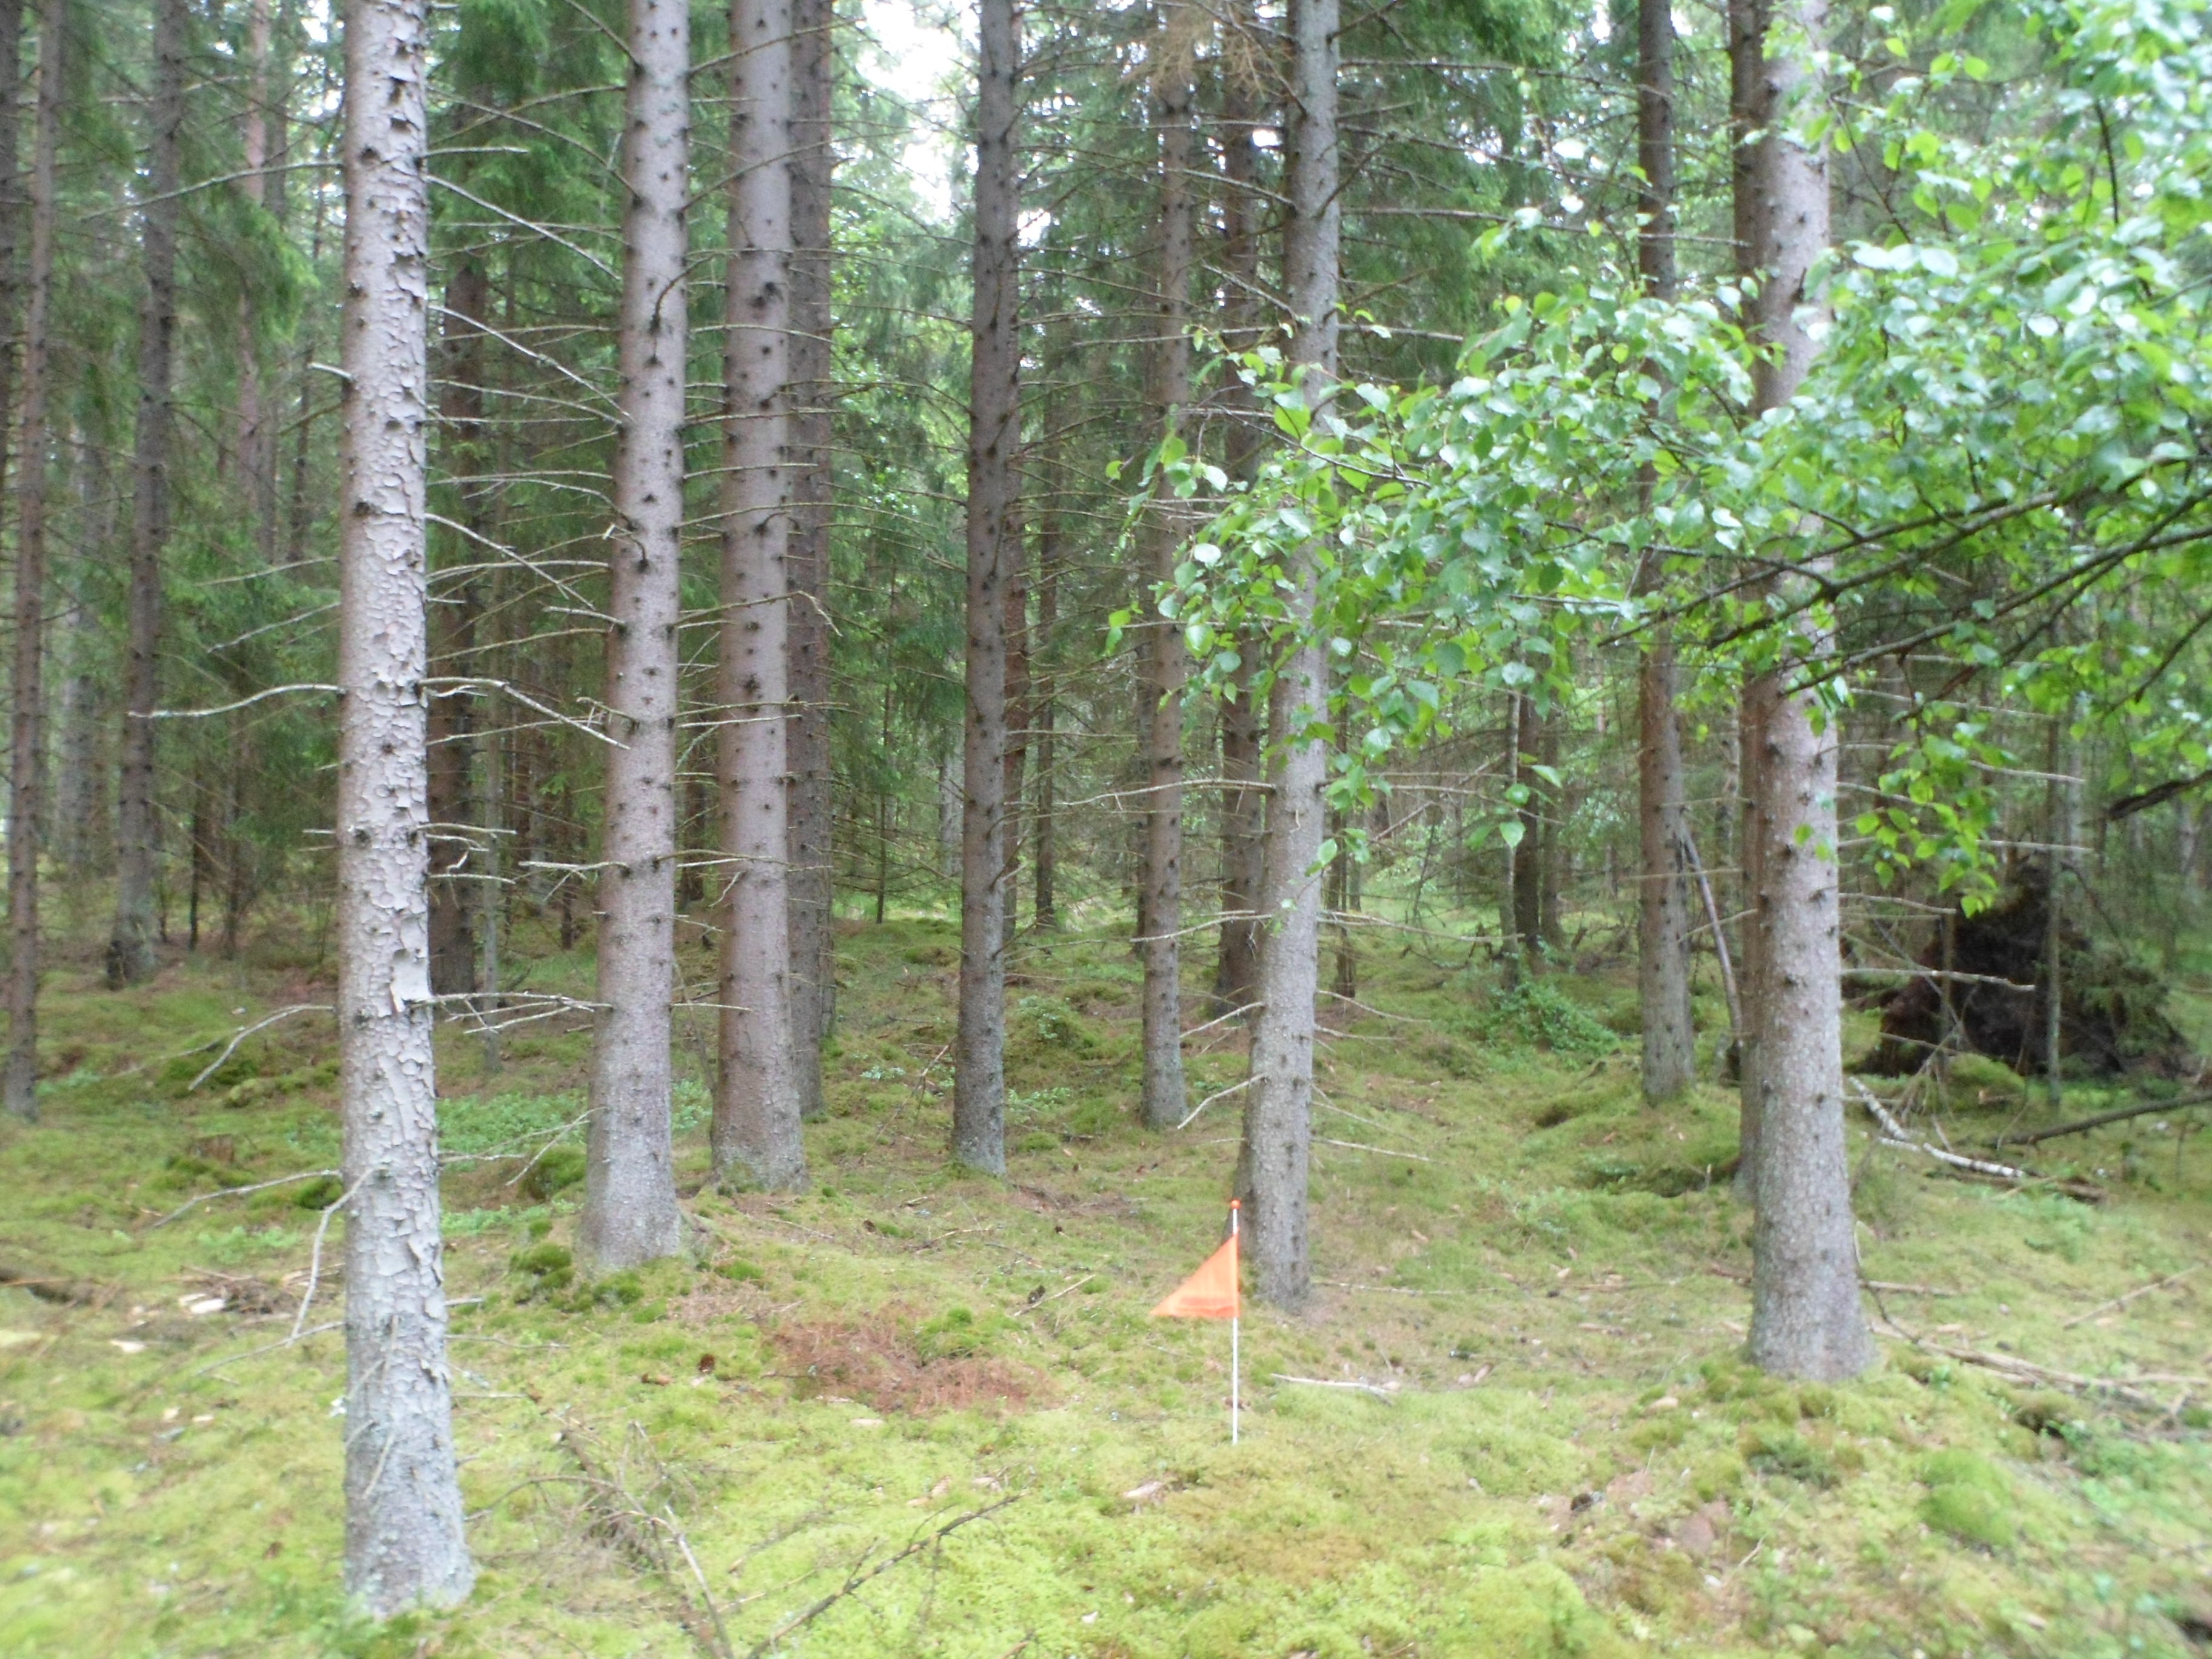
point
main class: Woodland
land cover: Spruce dominated coniferous woodland
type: boreal forest
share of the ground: > 75 %
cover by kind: coniferous forest trees 75 %, lichens and mosses 20 %, broadleaved forest trees 5 %
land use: Forestry
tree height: > 5 m
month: June
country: SE
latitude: 56.8291
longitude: 14.5035
